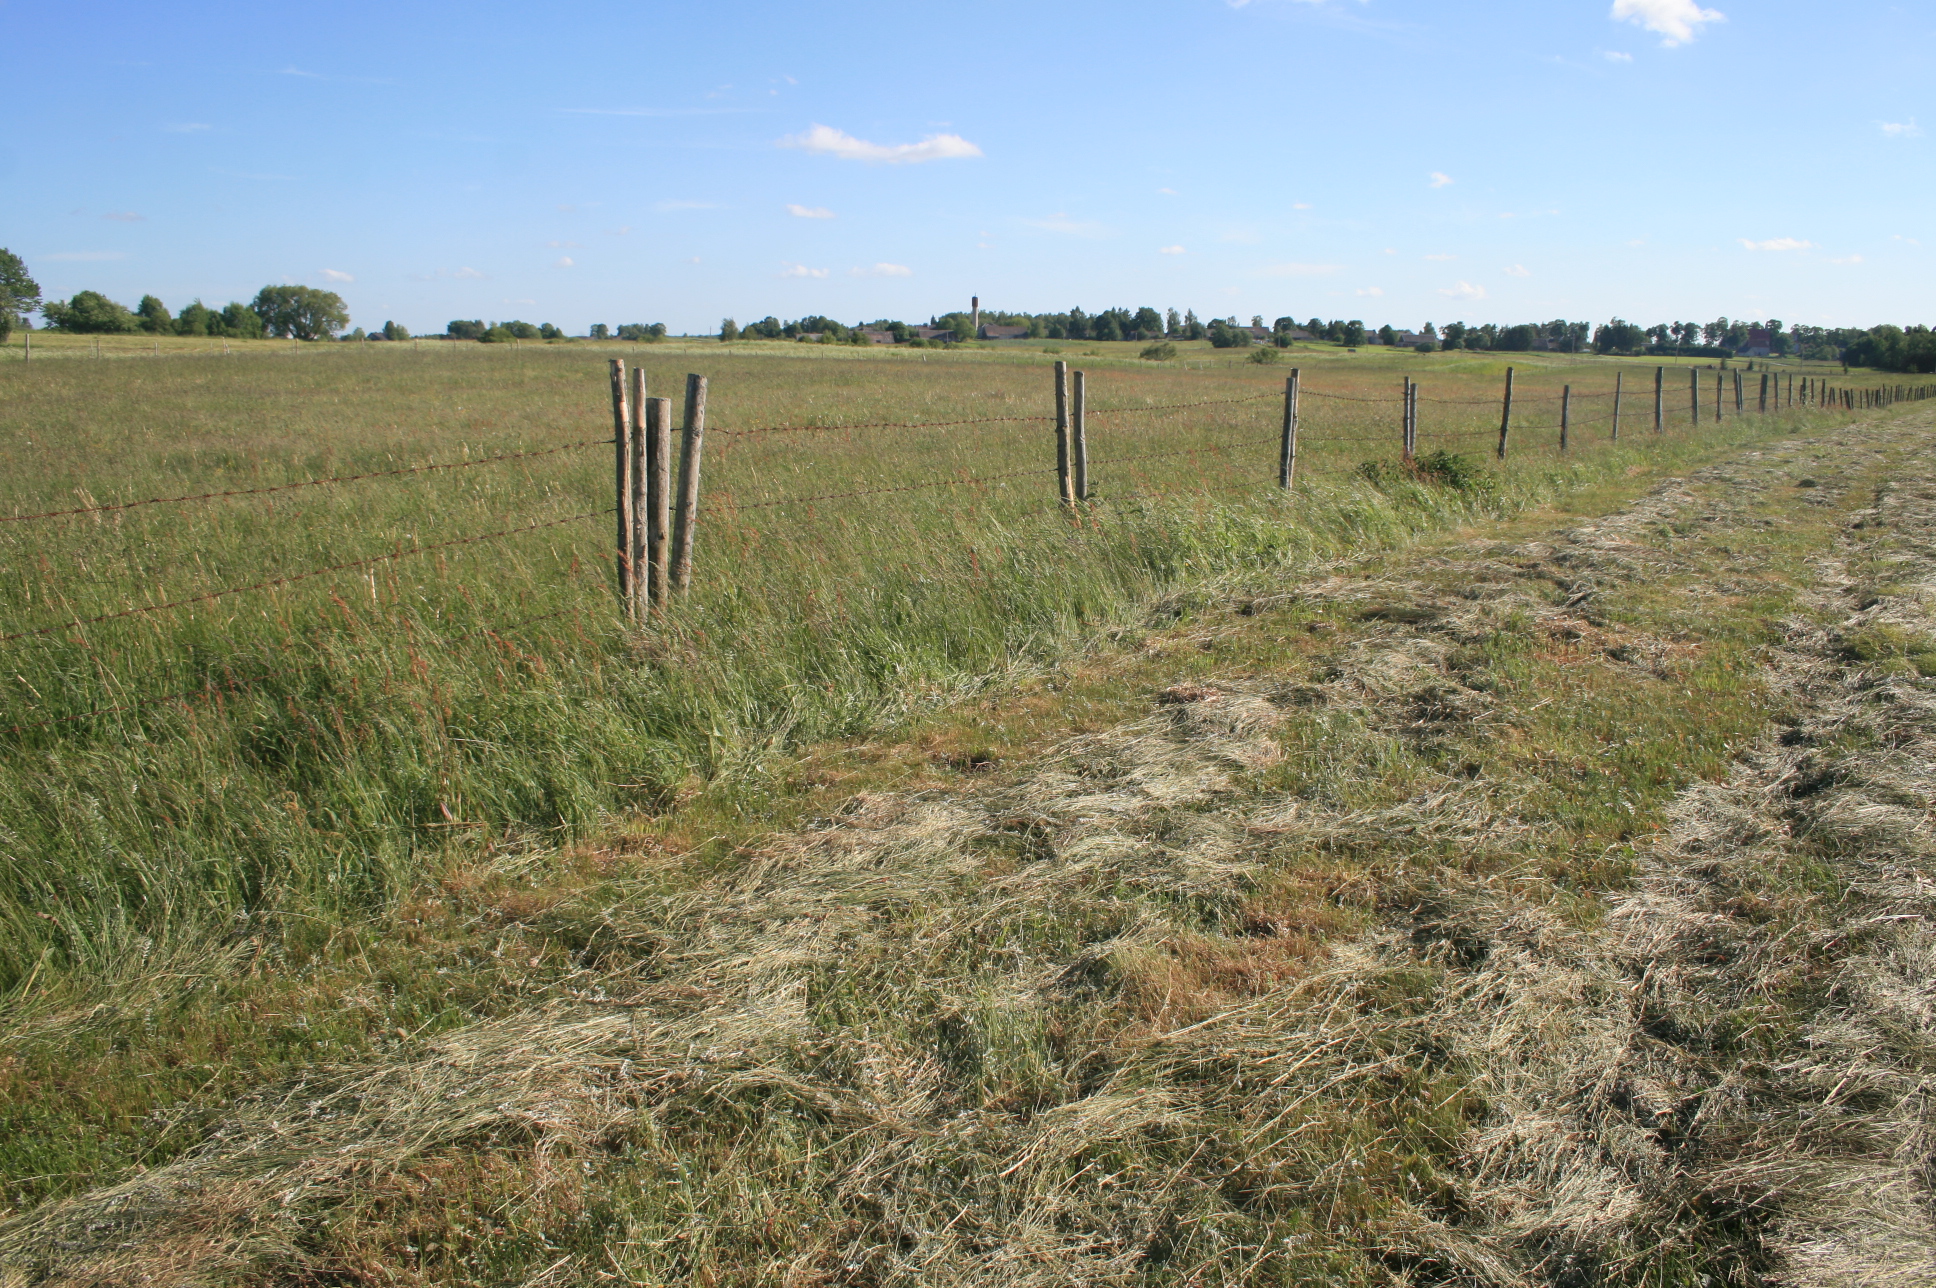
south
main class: Grassland
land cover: Grassland without tree/shrub cover
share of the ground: > 75 %
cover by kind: herbaceous plants 100 %
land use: Agriculture (excluding fallow land and kitchen gardens)
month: June
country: LT
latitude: 55.8206
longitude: 22.3959
